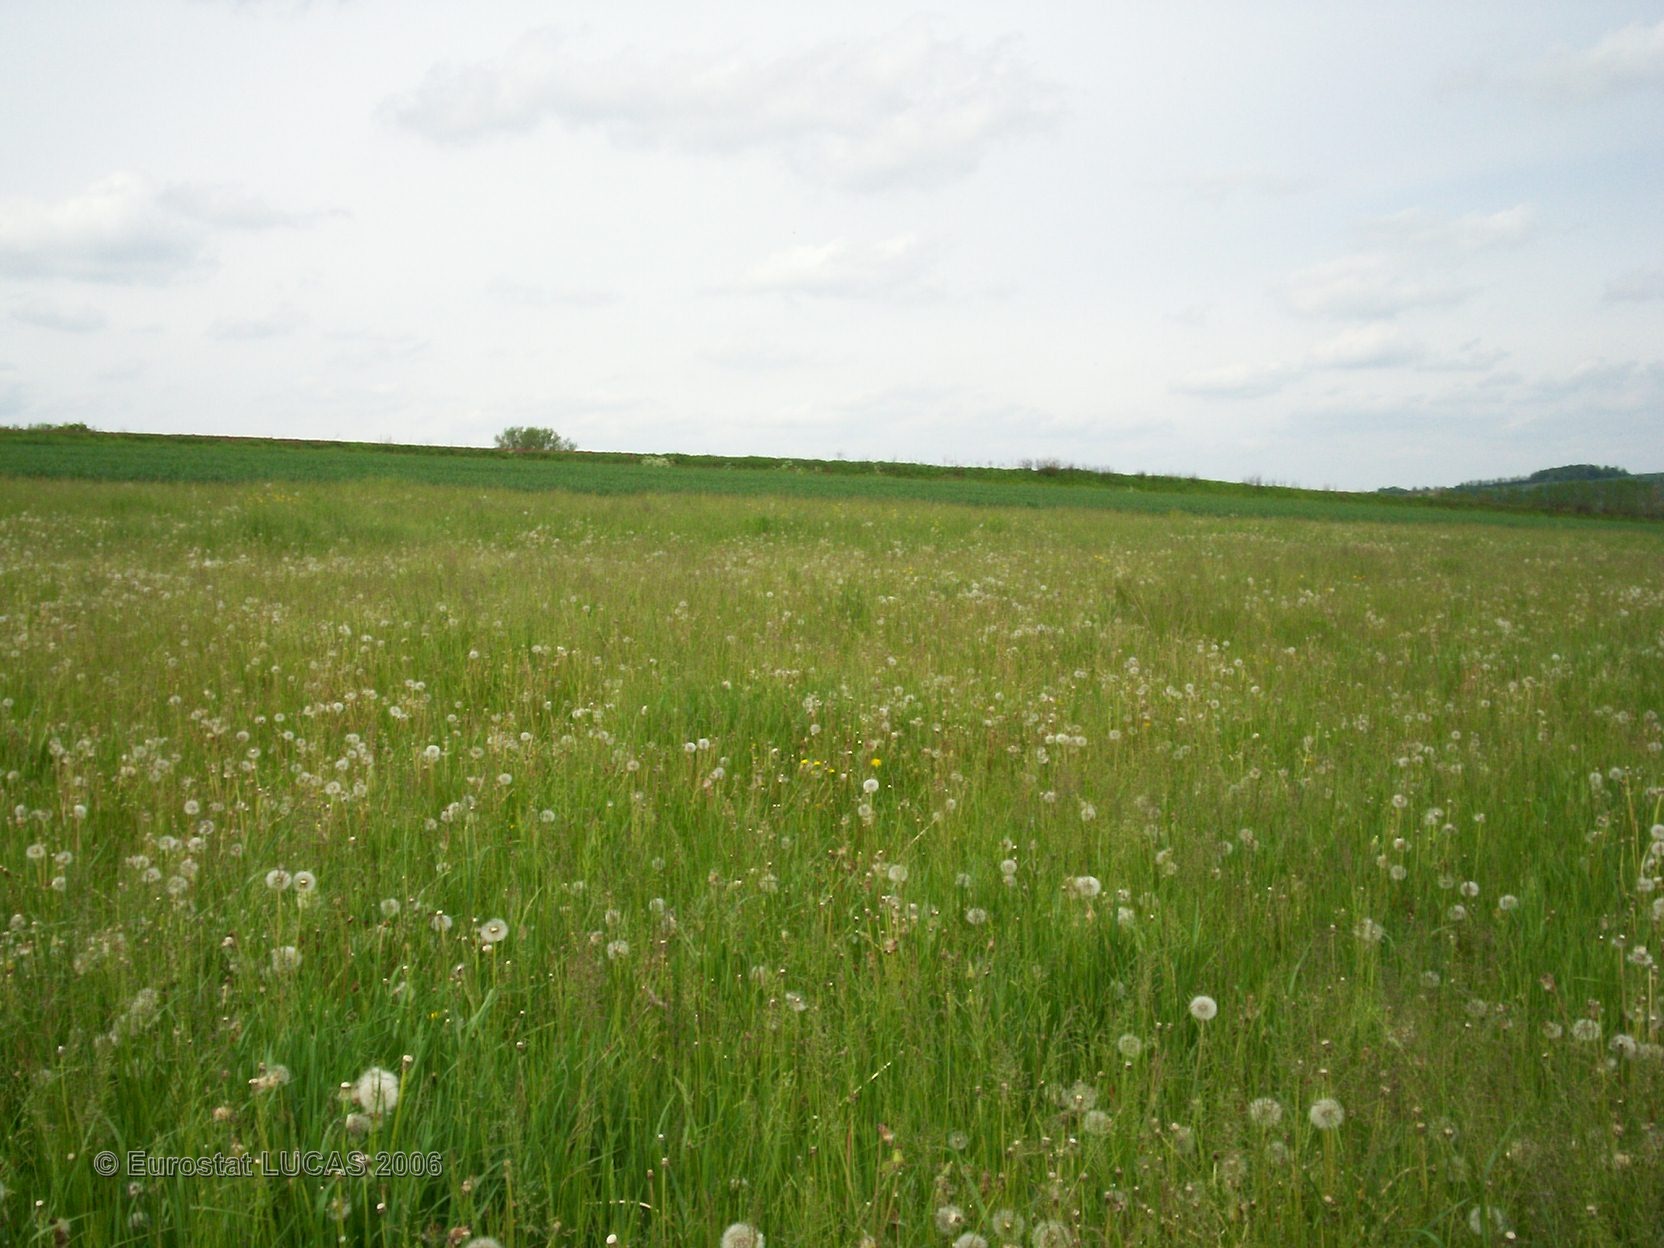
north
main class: Grassland
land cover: Grassland without tree/shrub cover
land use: Agriculture (excluding fallow land and kitchen gardens)
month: May
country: FR
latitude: 48.4398
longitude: 6.5535
